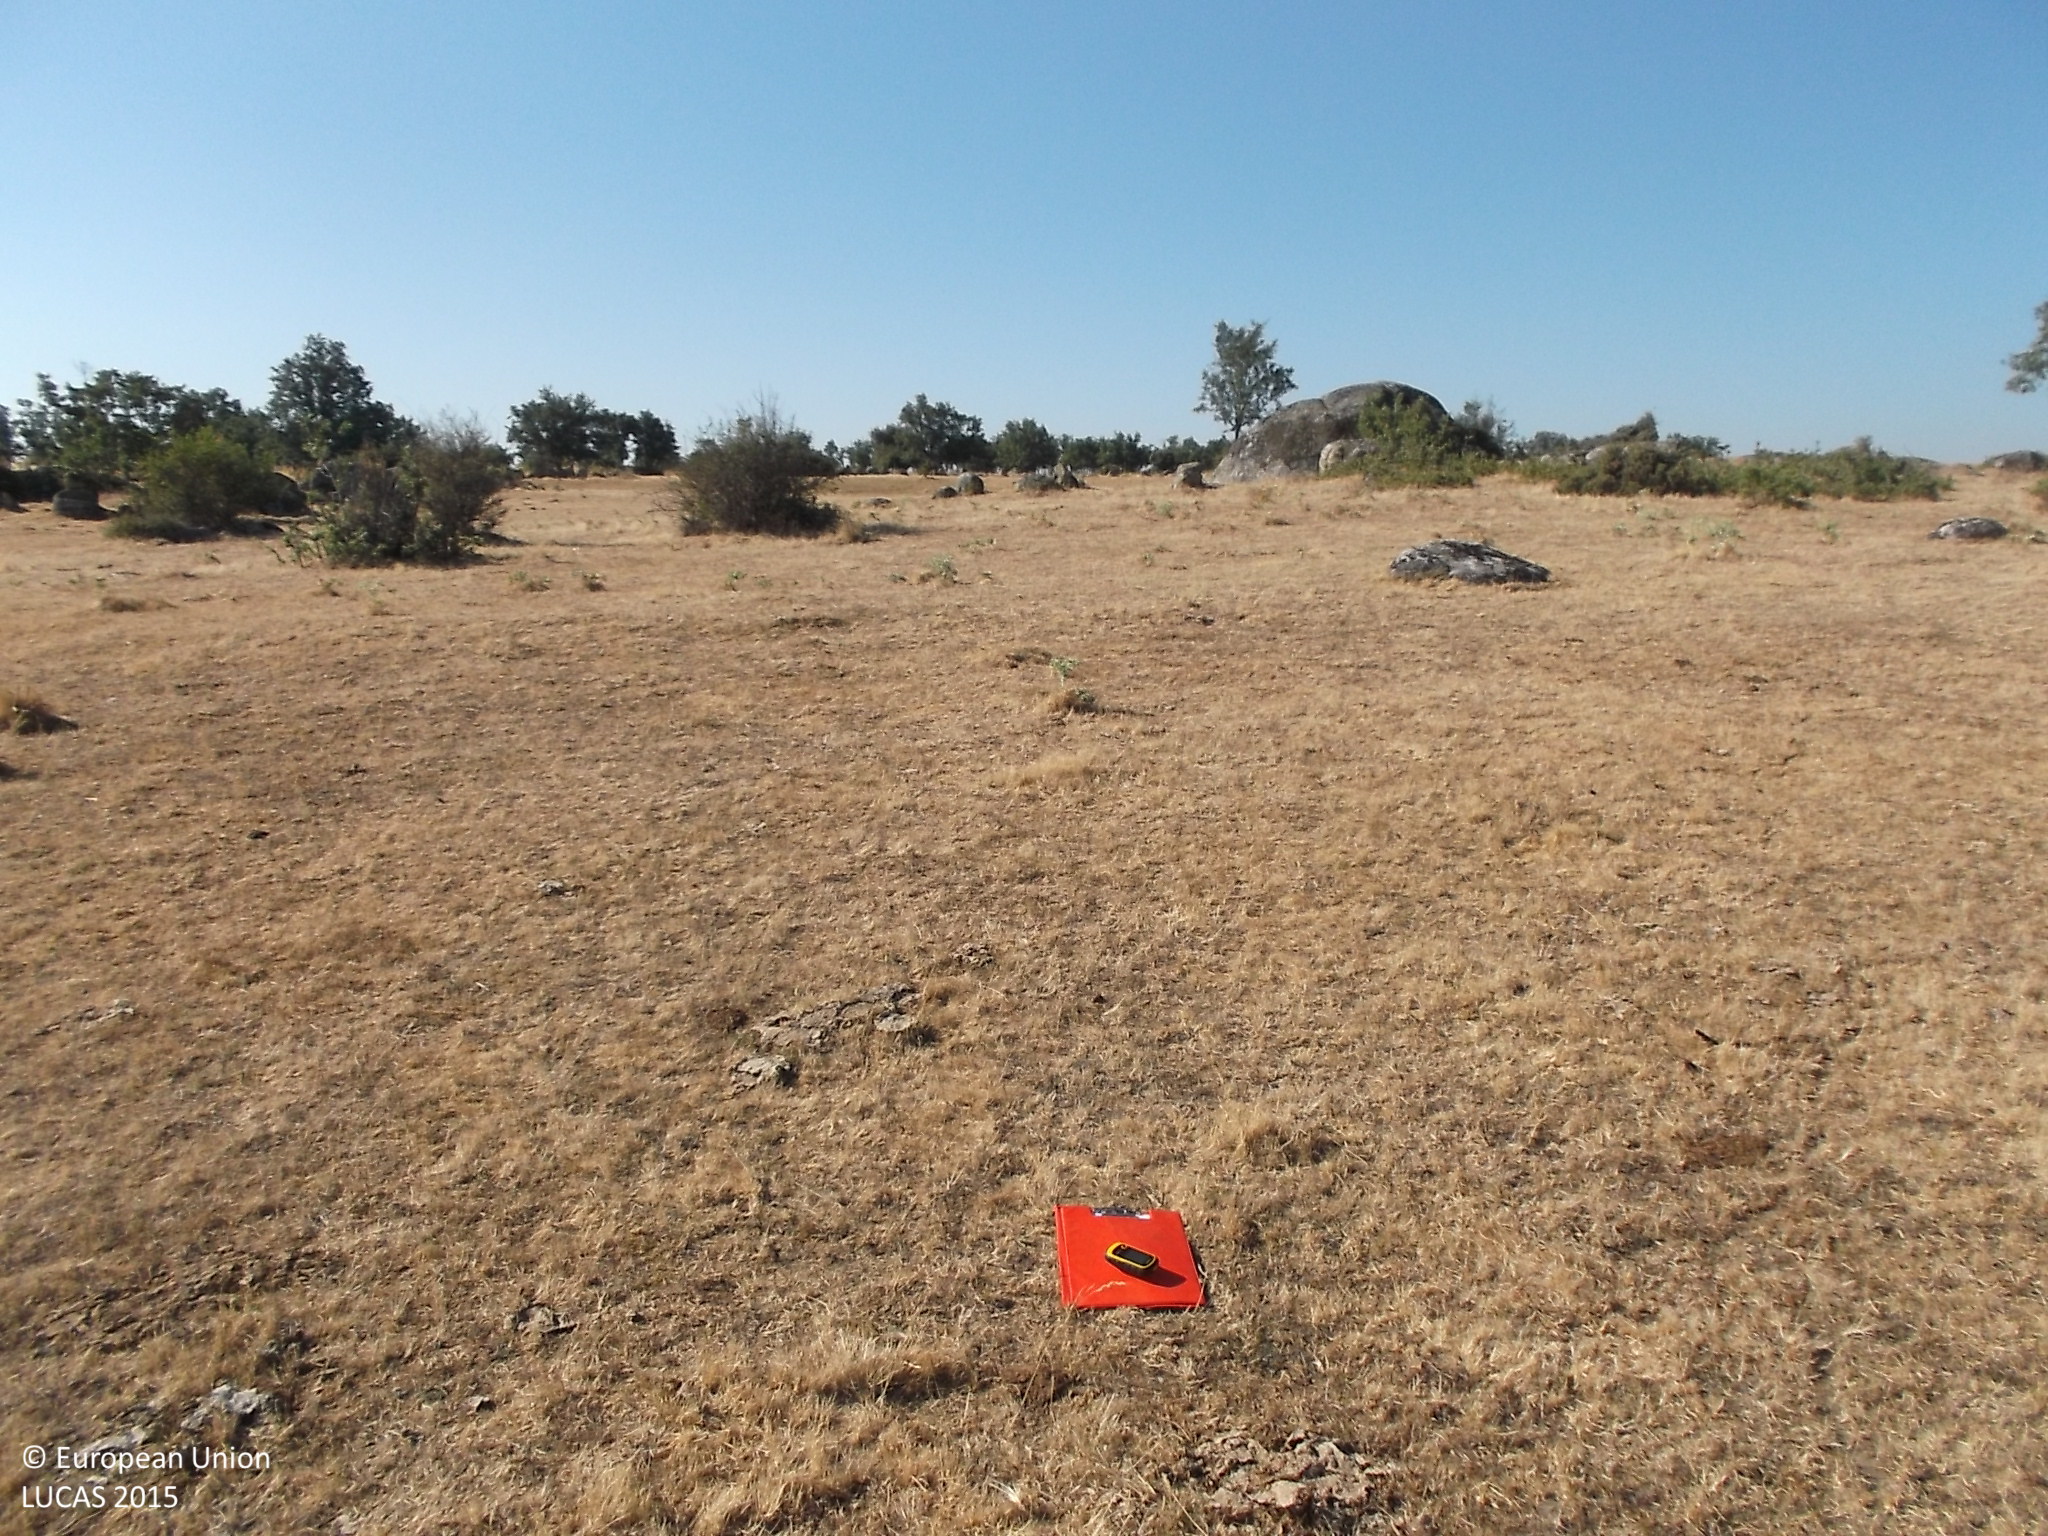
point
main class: Grassland
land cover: Grassland without tree/shrub cover
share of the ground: > 75 %
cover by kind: herbaceous plants 100 %
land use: Agriculture (excluding fallow land and kitchen gardens)
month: July
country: ES
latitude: 41.3329
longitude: -6.0175
